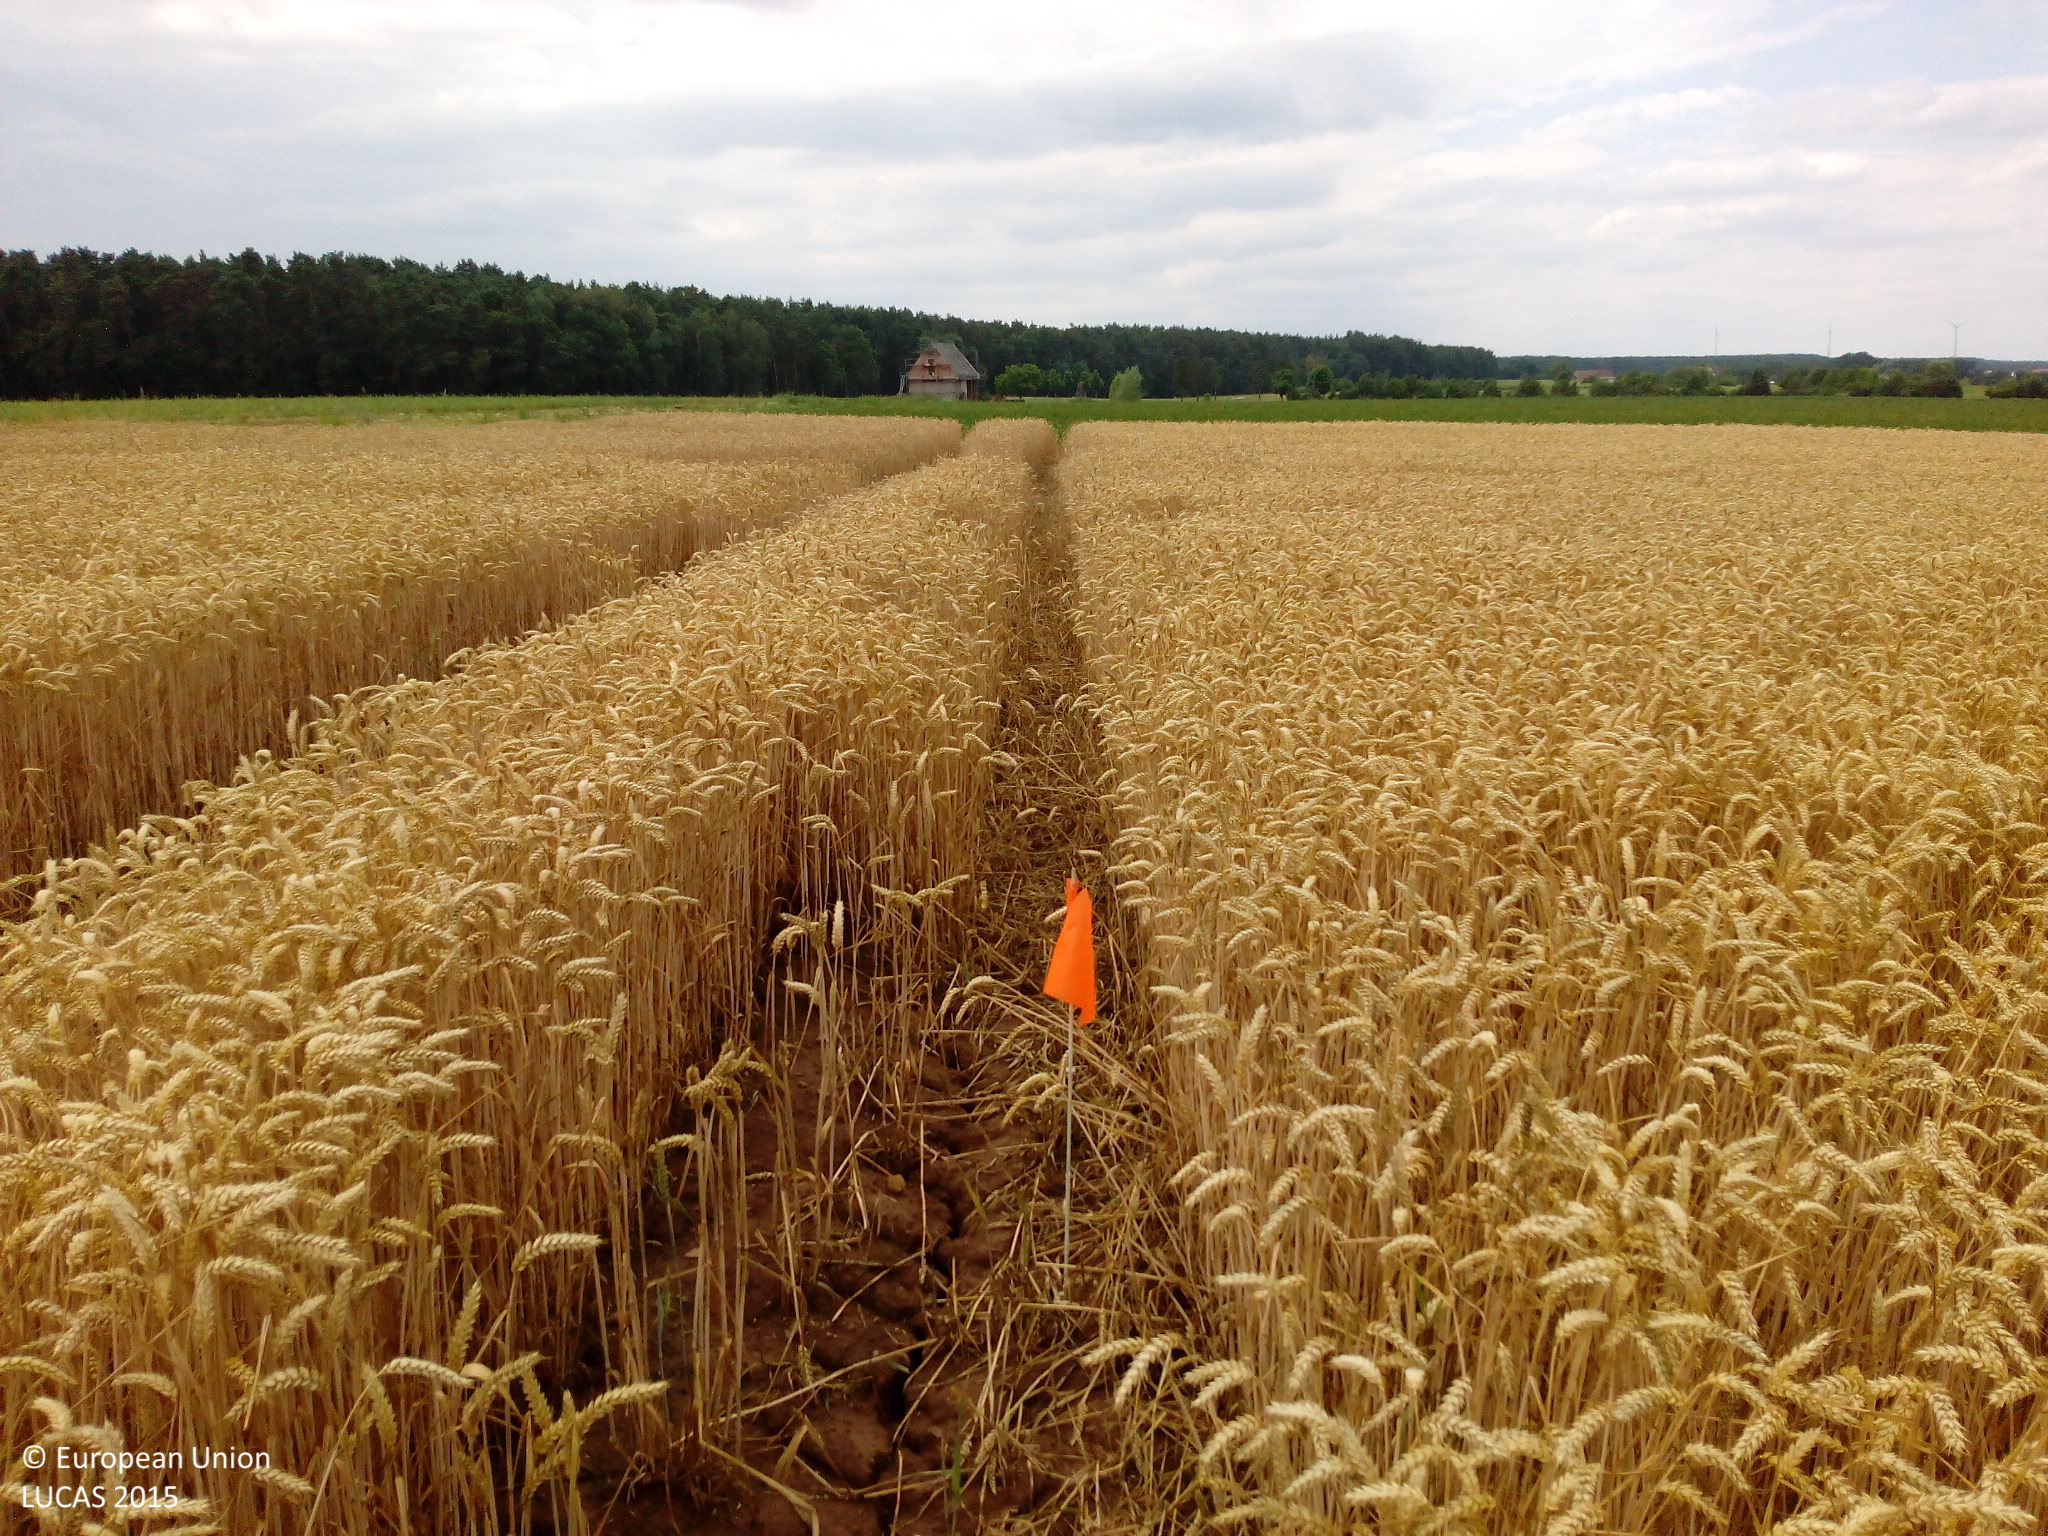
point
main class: Cropland
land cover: Common wheat
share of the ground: > 75 %
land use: Agriculture (excluding fallow land and kitchen gardens)
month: July
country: DE
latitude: 49.5512
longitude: 10.8981
